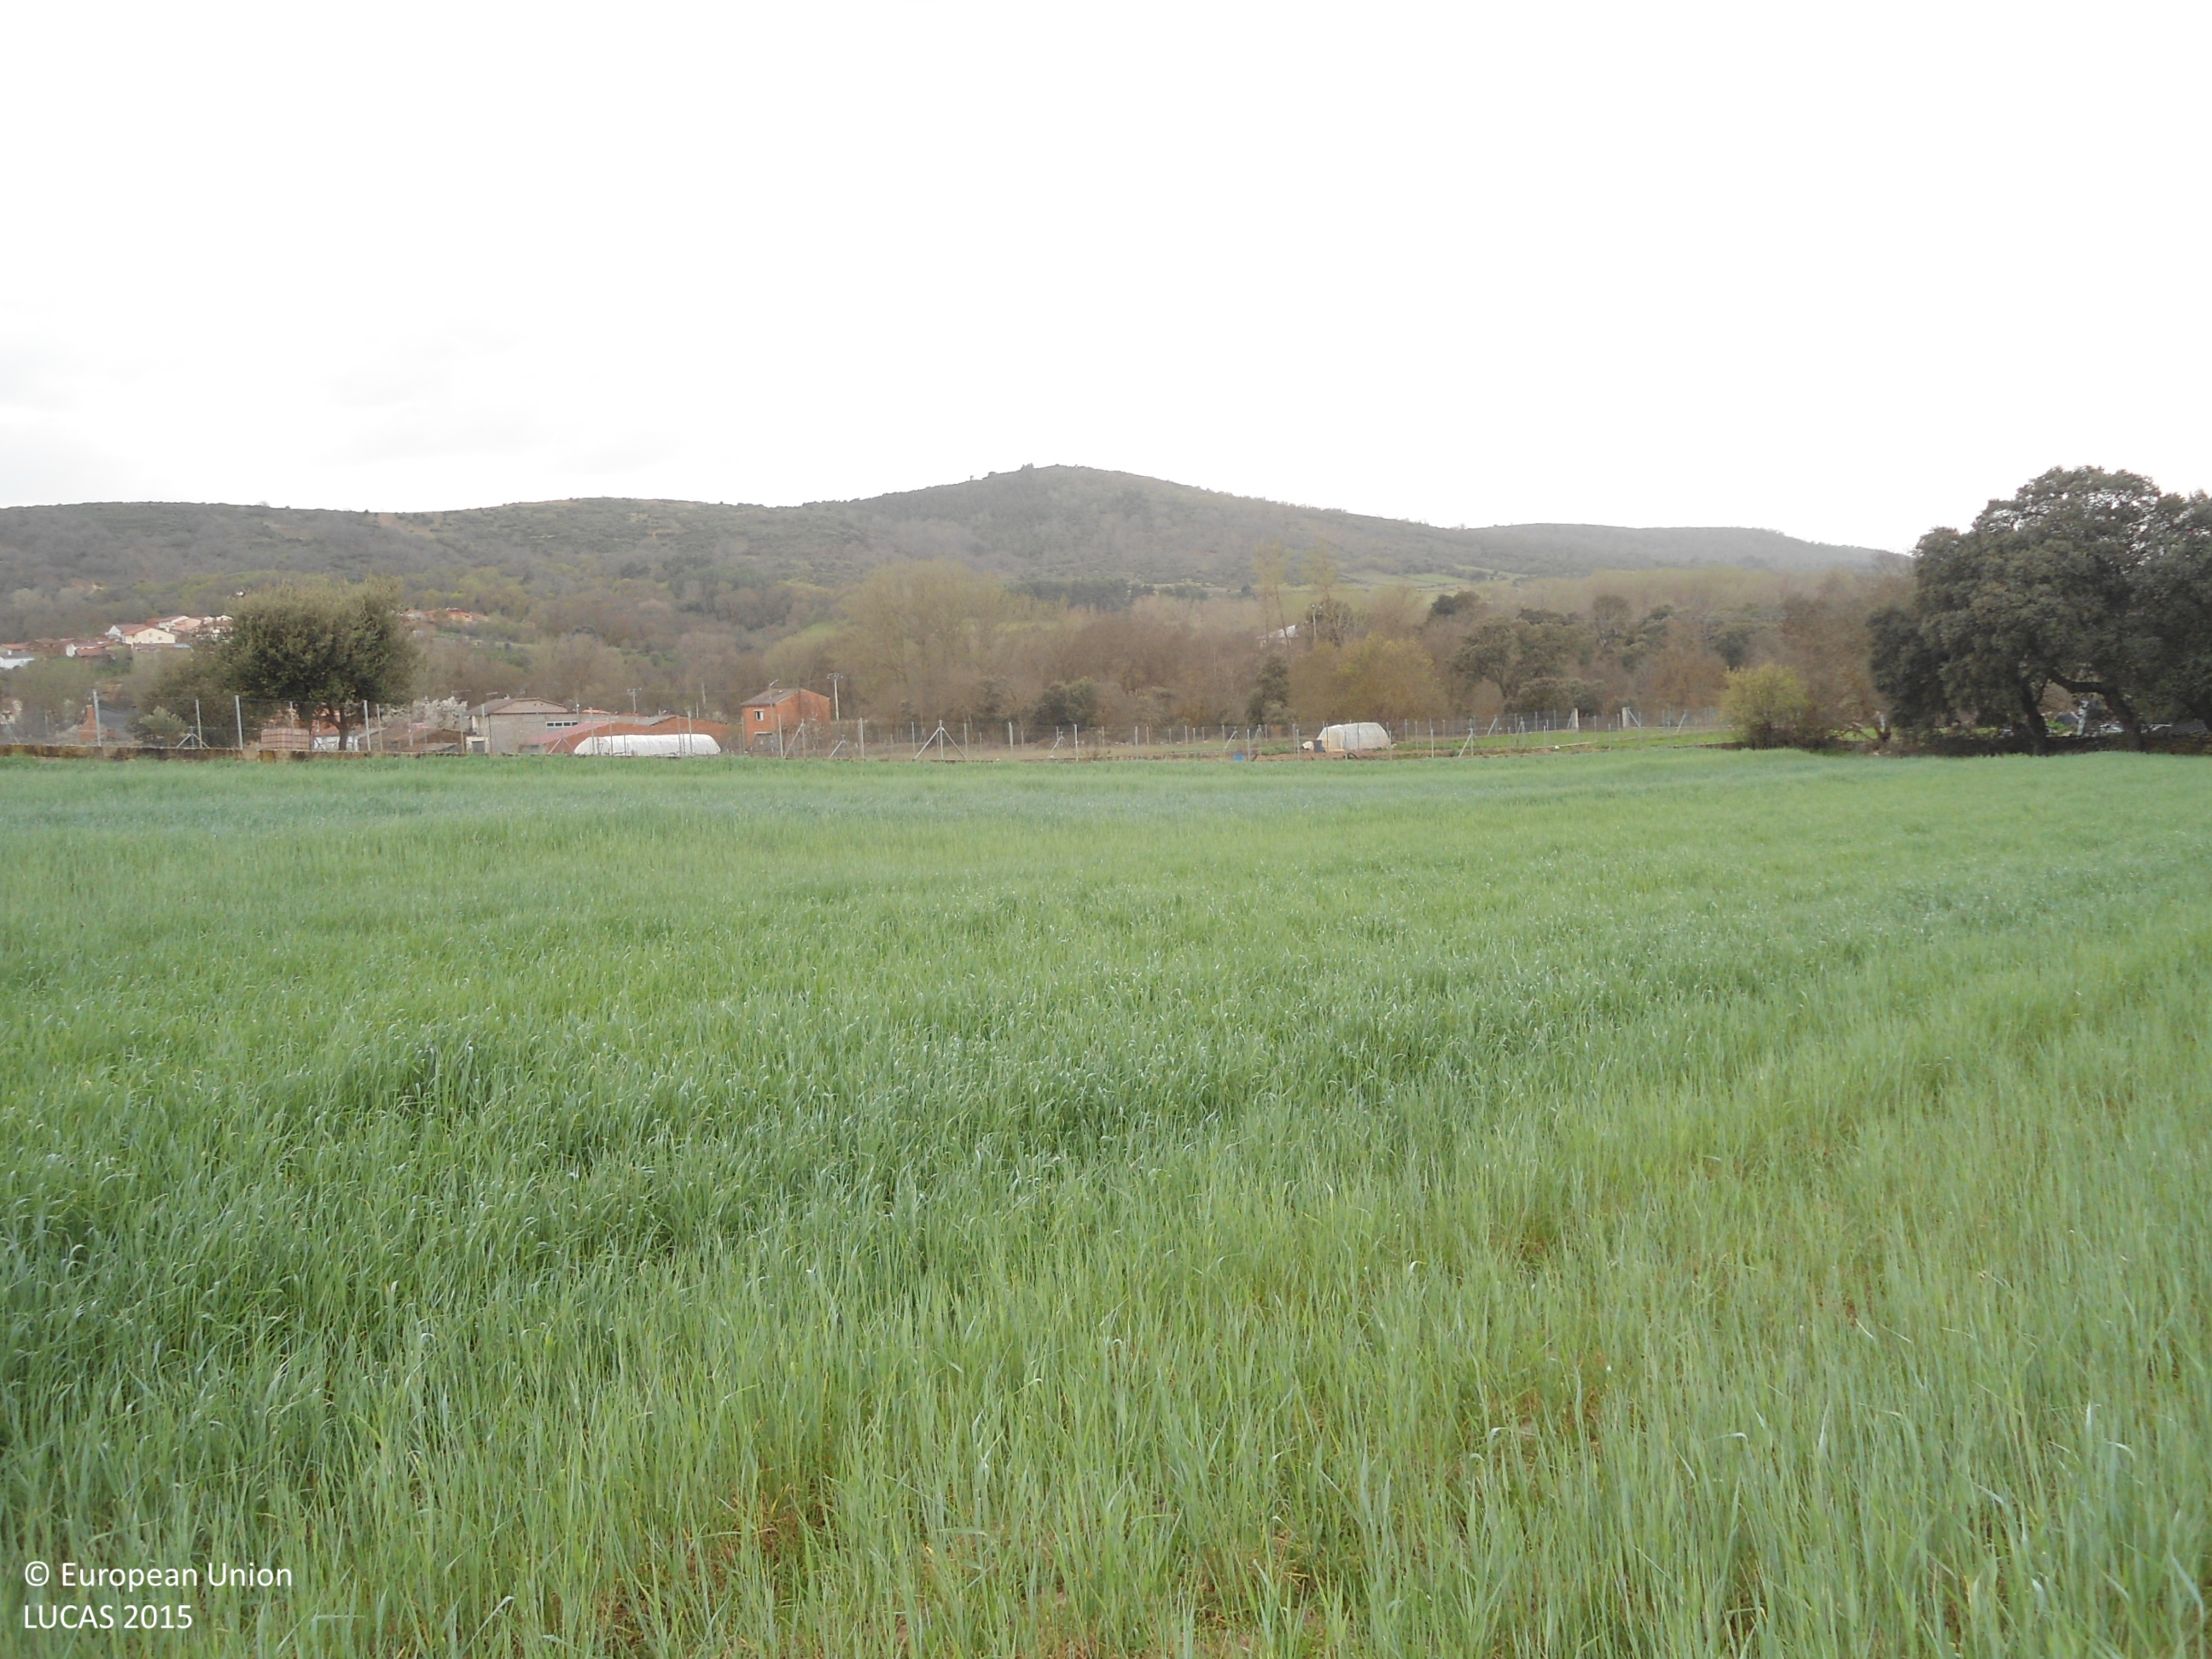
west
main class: Cropland
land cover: Rye
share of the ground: > 75 %
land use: Agriculture (excluding fallow land and kitchen gardens)
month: April
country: ES
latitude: 41.8244
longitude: -6.2715
